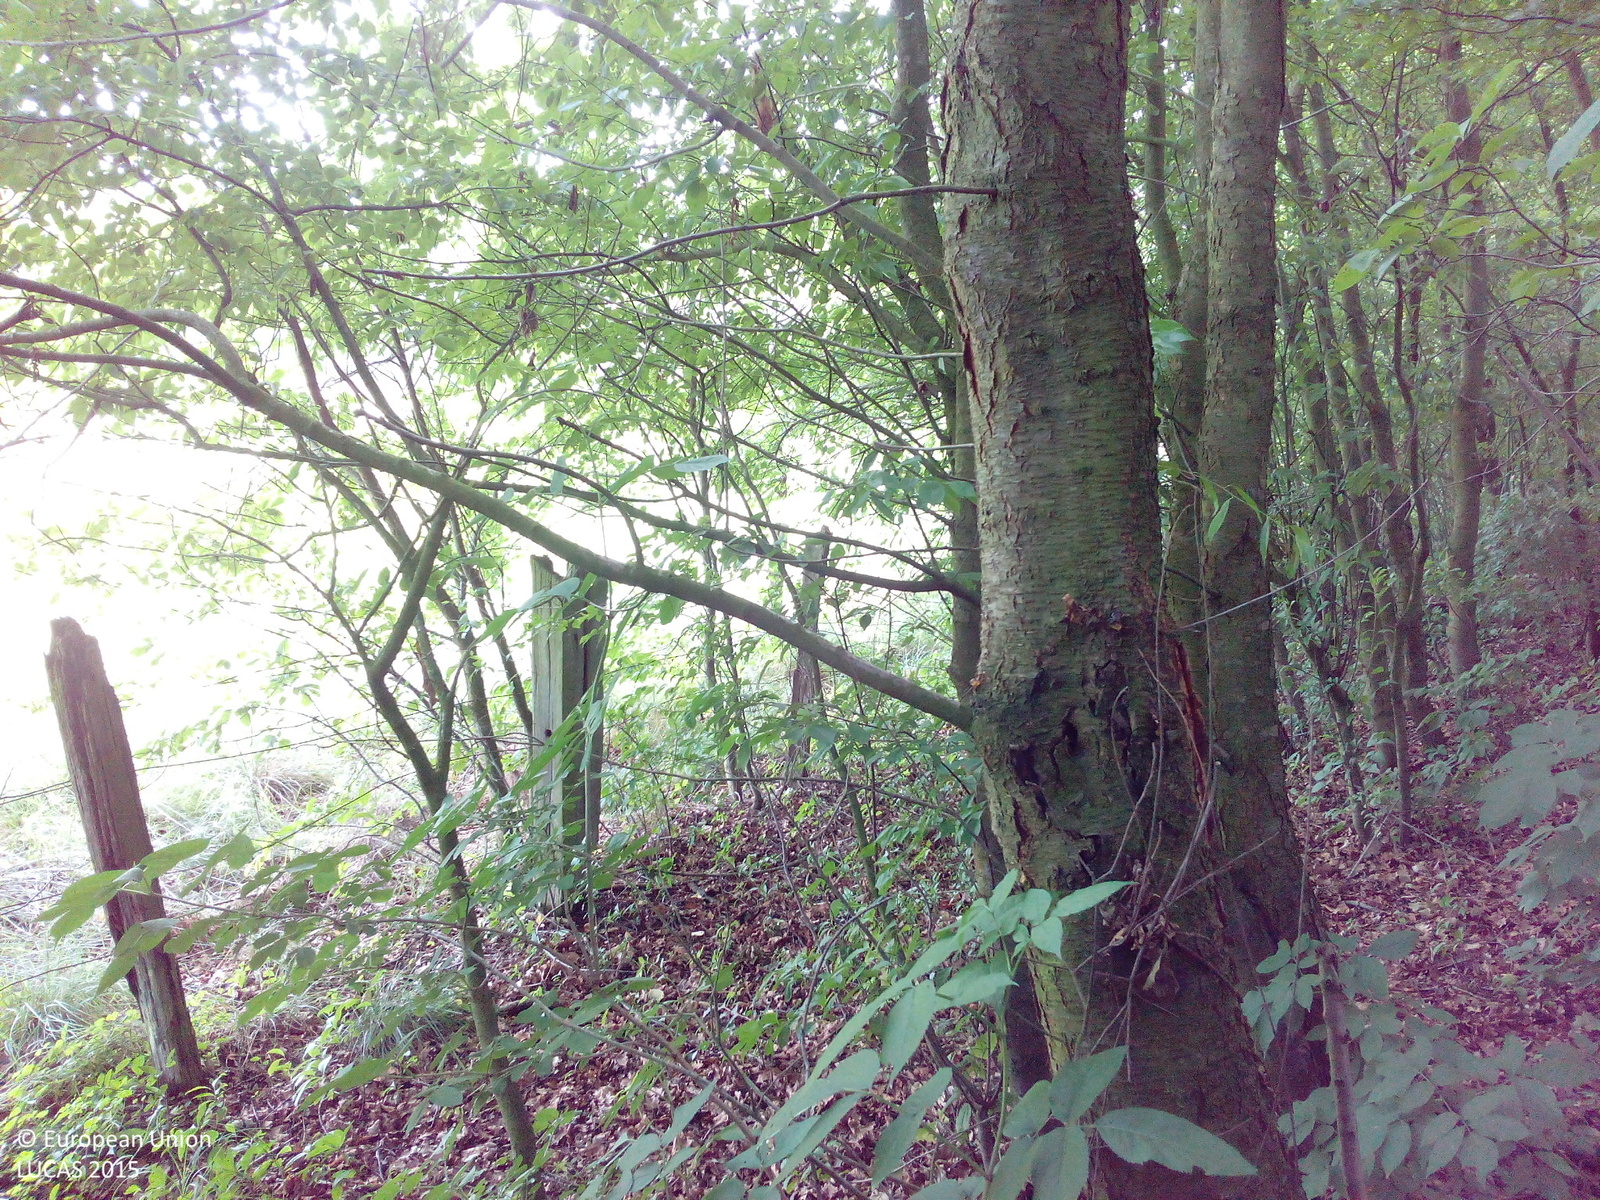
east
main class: Woodland
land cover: Broadleaved woodland
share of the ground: > 75 %
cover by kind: broadleaved forest trees 95 %, unconsolidated bare surface 5 %
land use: Forestry
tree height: > 5 m
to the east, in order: Broadleaved woodland; Fences; Grass margins; Fences; Grassland without tree/shrub cover; Fences; Pine dominated mixed woodland; Paved roads, cycling and walking lanes; Broadleaved woodland
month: July
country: DE
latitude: 53.0675
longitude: 11.6261
